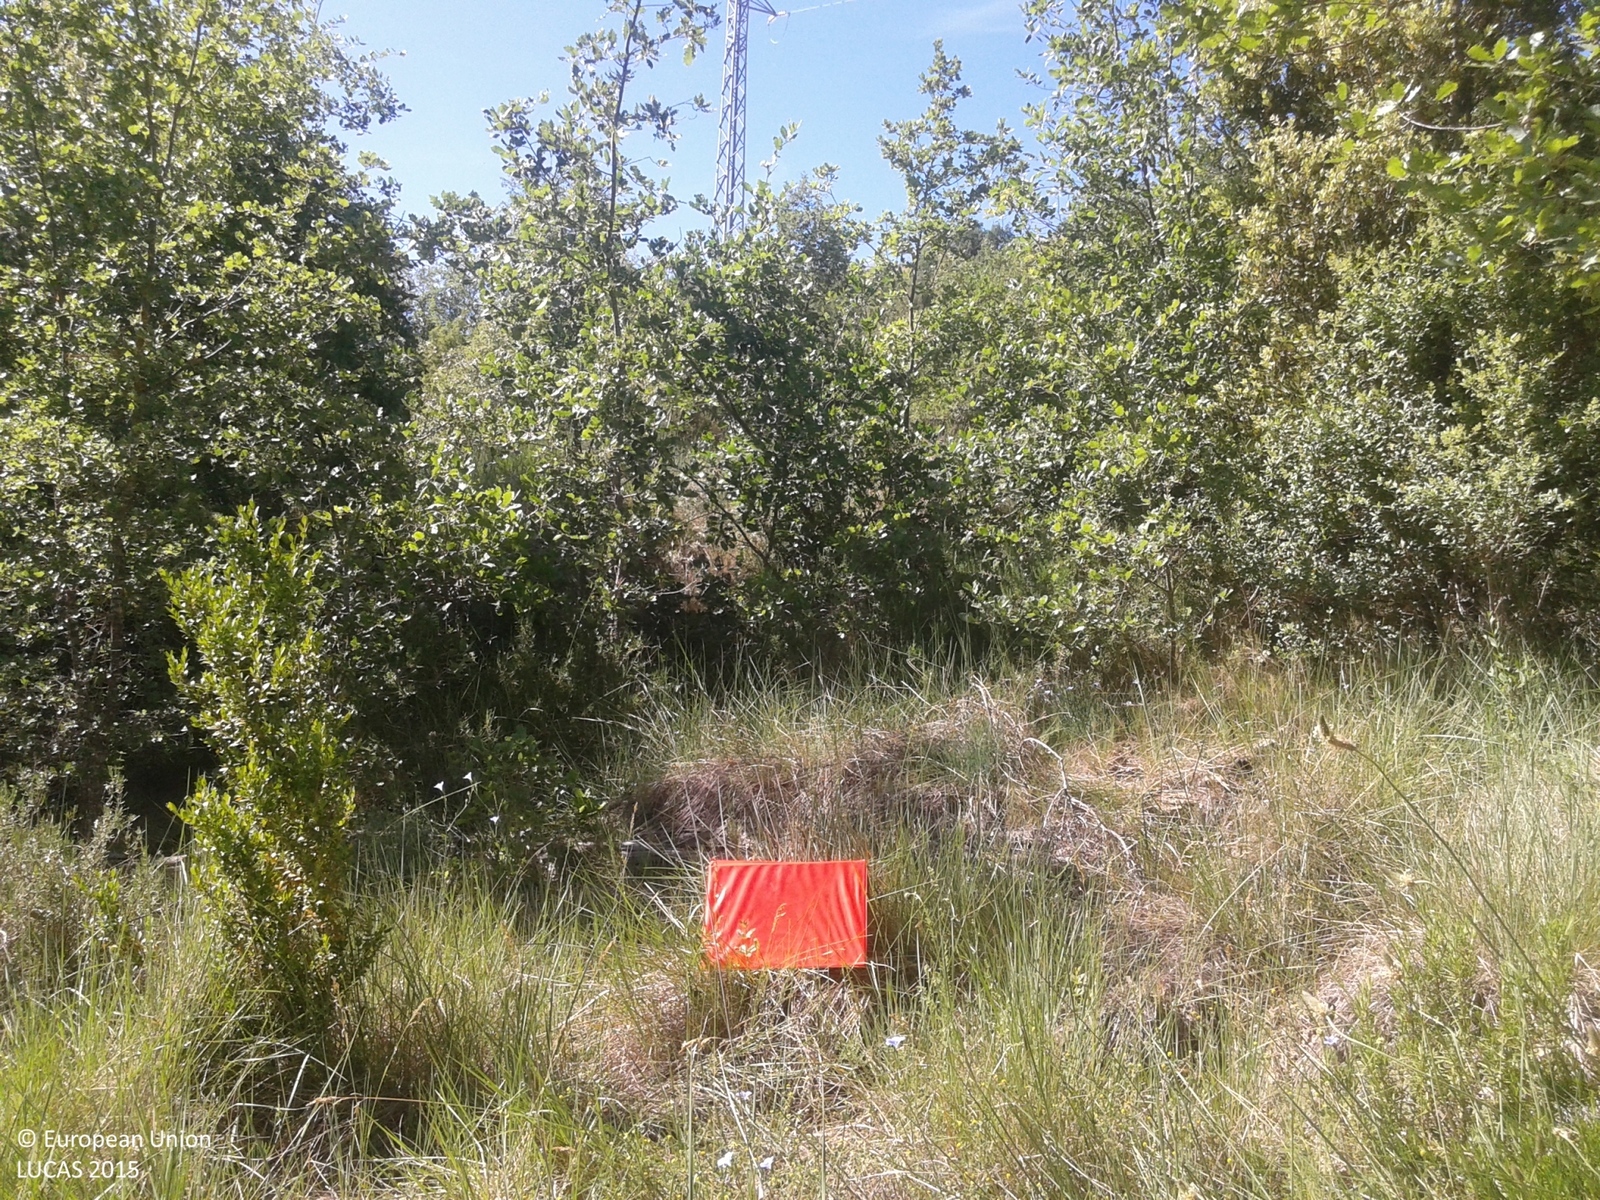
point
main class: Woodland
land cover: Broadleaved woodland
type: thermophilous deciduous forest
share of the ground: 50 - 75 %
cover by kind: broadleaved forest trees 65 %, shrubs 30 %, herbaceous plants 5 %
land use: Semi-natural and natural areas not in use
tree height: < 5 m
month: May
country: ES
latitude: 41.8324
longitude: 1.5970
